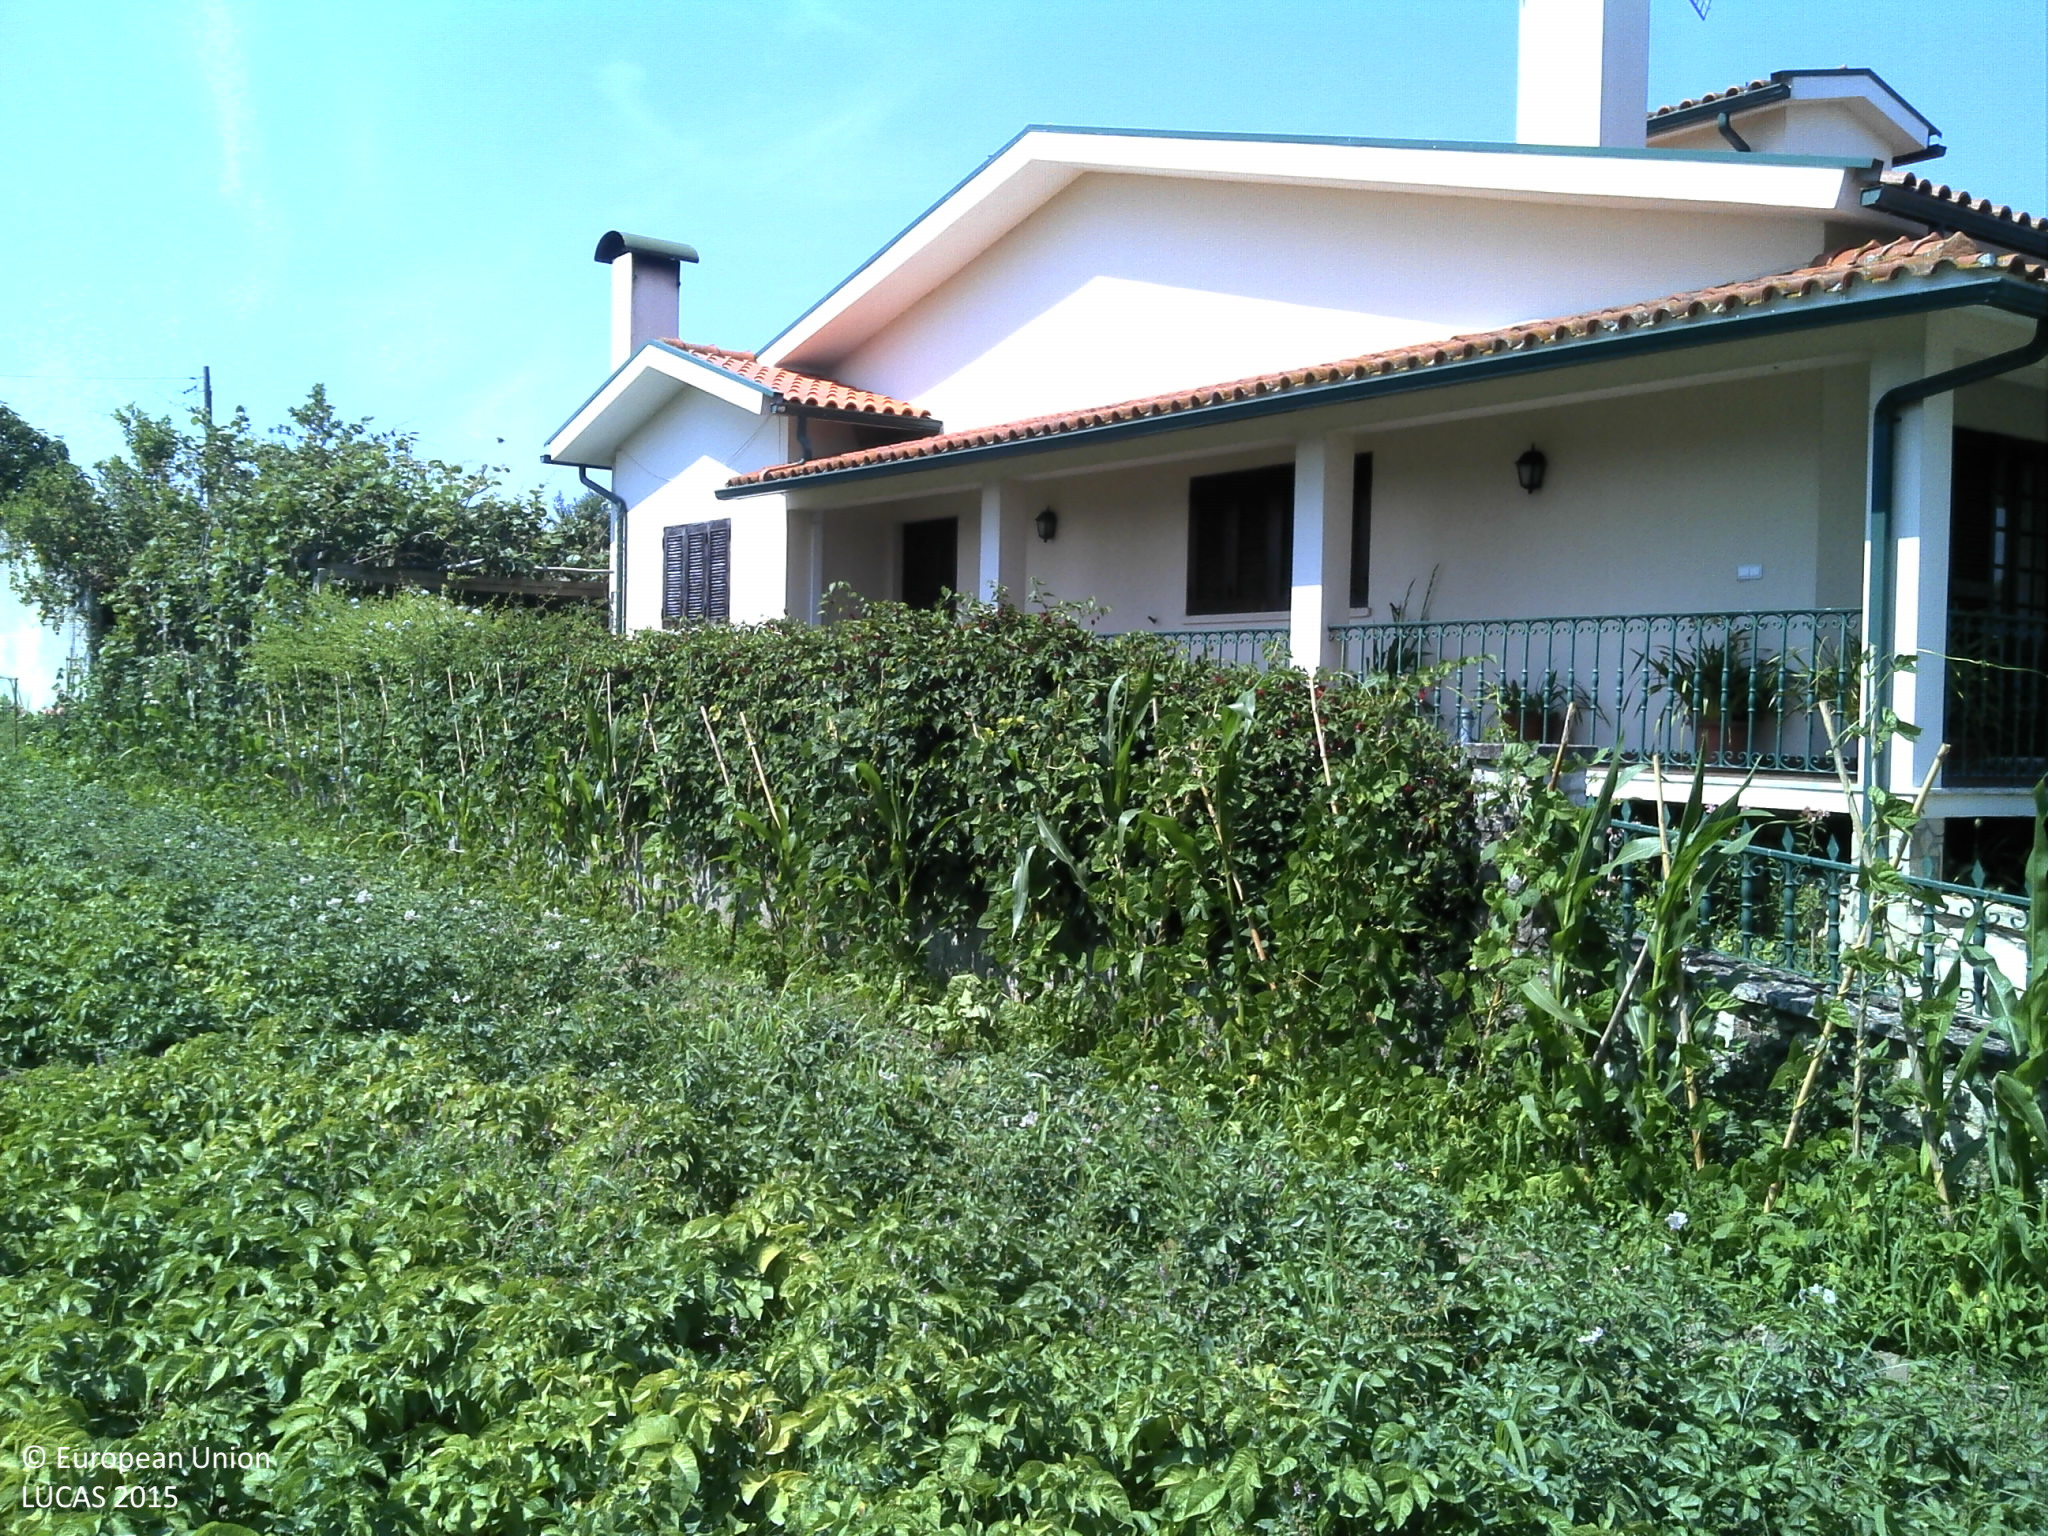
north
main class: Cropland
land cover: Potatoes
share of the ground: > 75 %
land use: Kitchen garden
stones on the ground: < 10 %
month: June
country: PT
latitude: 40.2203
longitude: -8.5481
